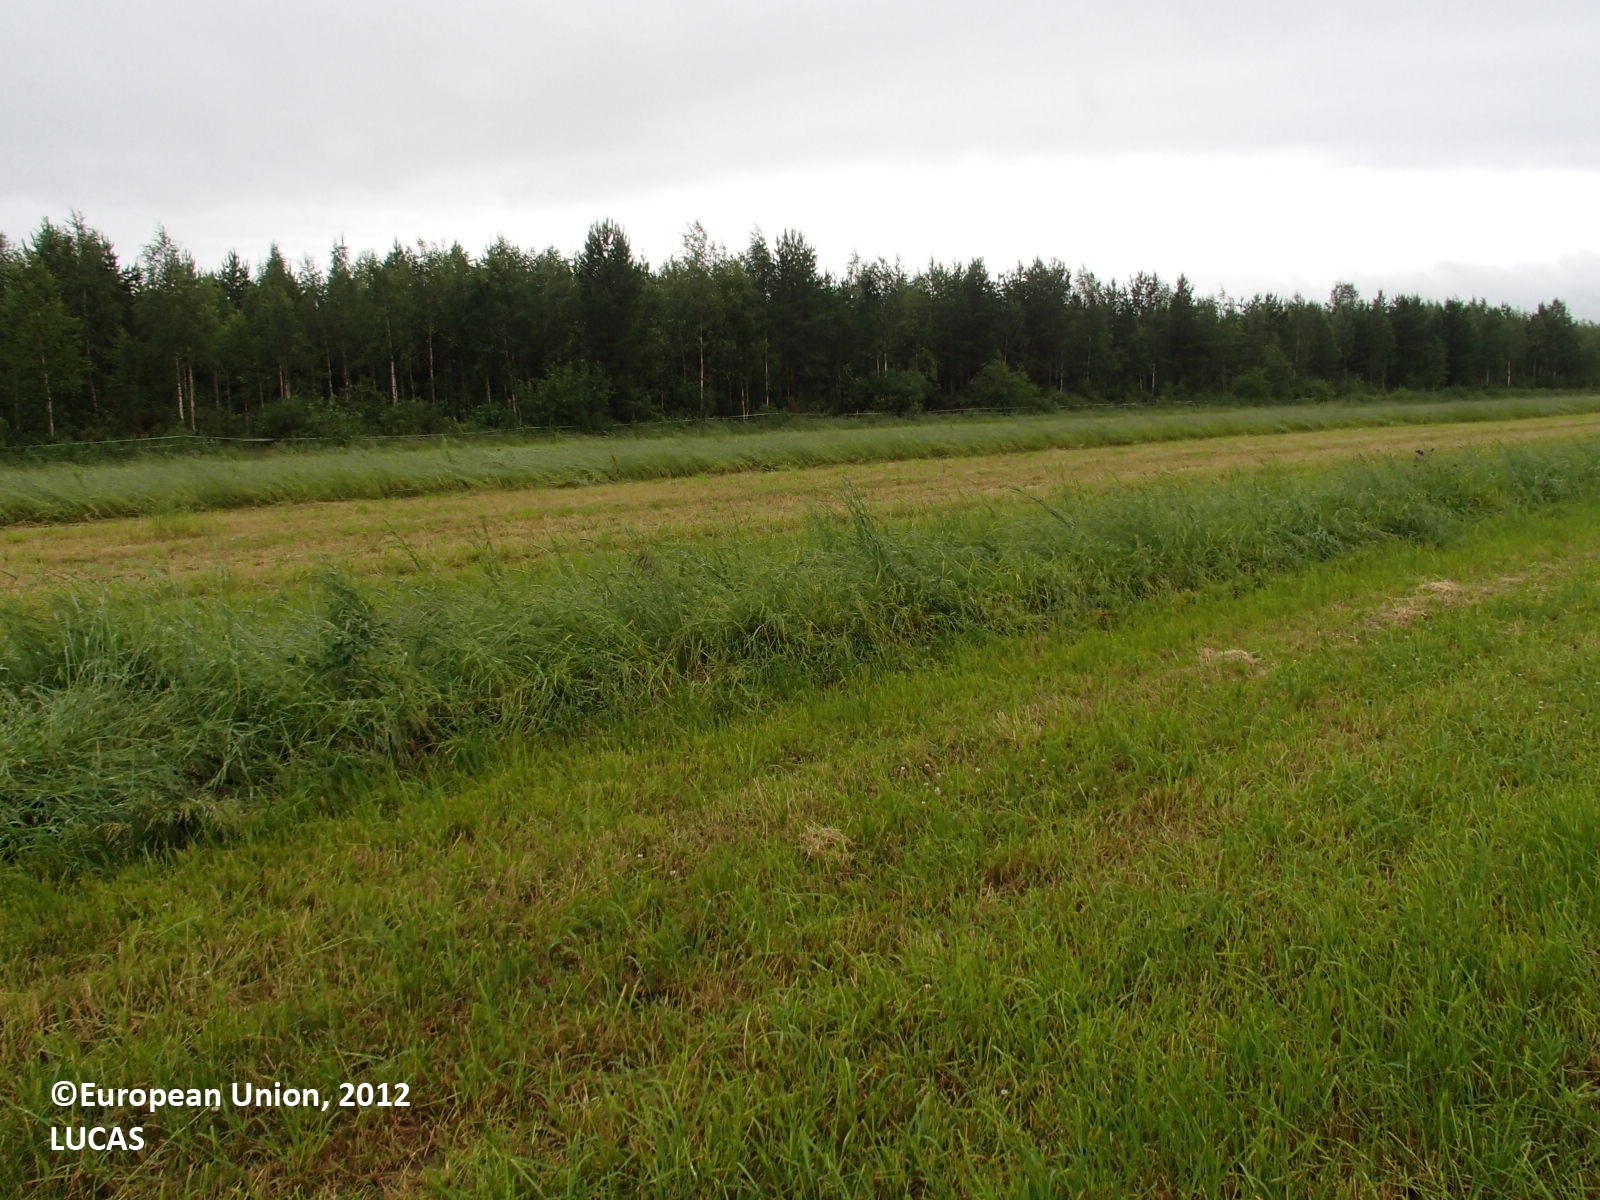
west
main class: Cropland
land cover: Temporary grasslands
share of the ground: > 75 %
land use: Agriculture (excluding fallow land and kitchen gardens)
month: July
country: FI
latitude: 64.4072
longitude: 26.4004
